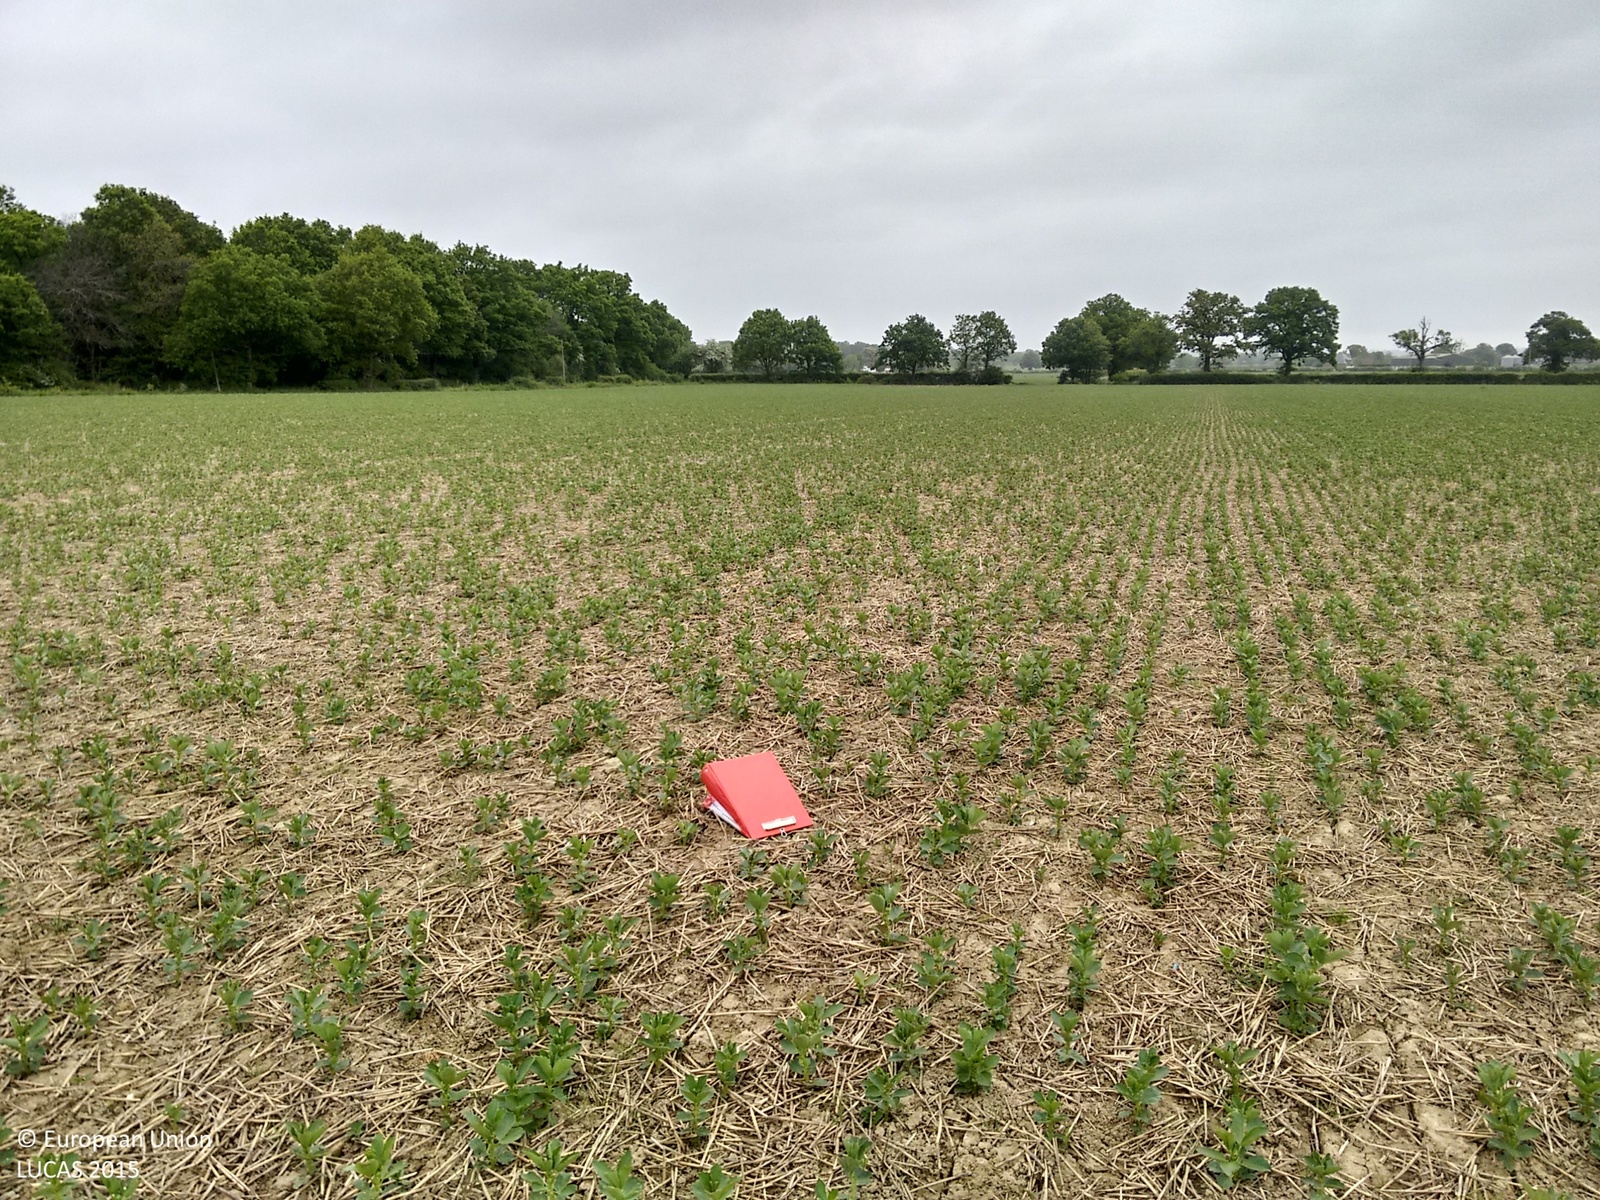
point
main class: Cropland
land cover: Dry pulses
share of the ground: 10 - 25 %
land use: Agriculture (excluding fallow land and kitchen gardens)
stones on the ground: < 10 %
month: May
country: GB
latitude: 51.1467
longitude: 0.5234
